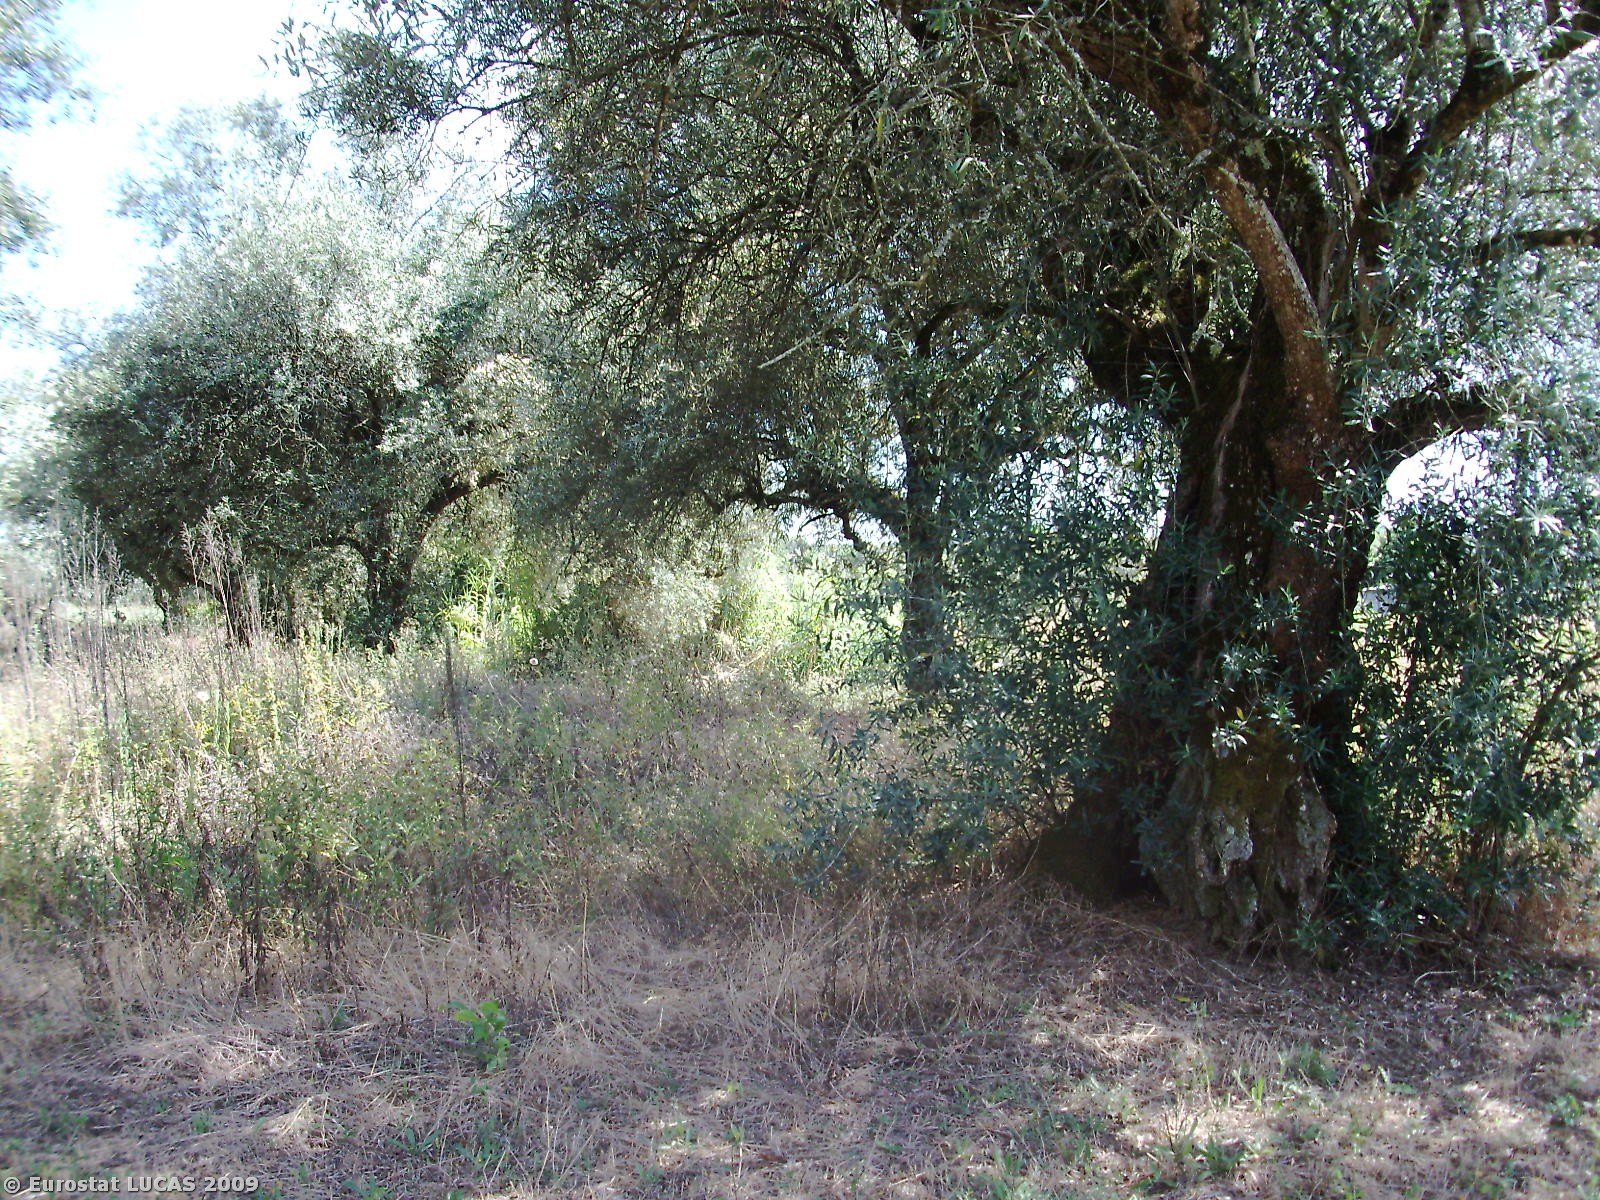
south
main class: Cropland
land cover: Olive groves
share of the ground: 25 - 50 %
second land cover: Spontaneously vegetated surfaces
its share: 10 - 25 %
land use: Agriculture (excluding fallow land and kitchen gardens)
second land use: Fallow land
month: August
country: PT
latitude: 40.1284
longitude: -8.5450
